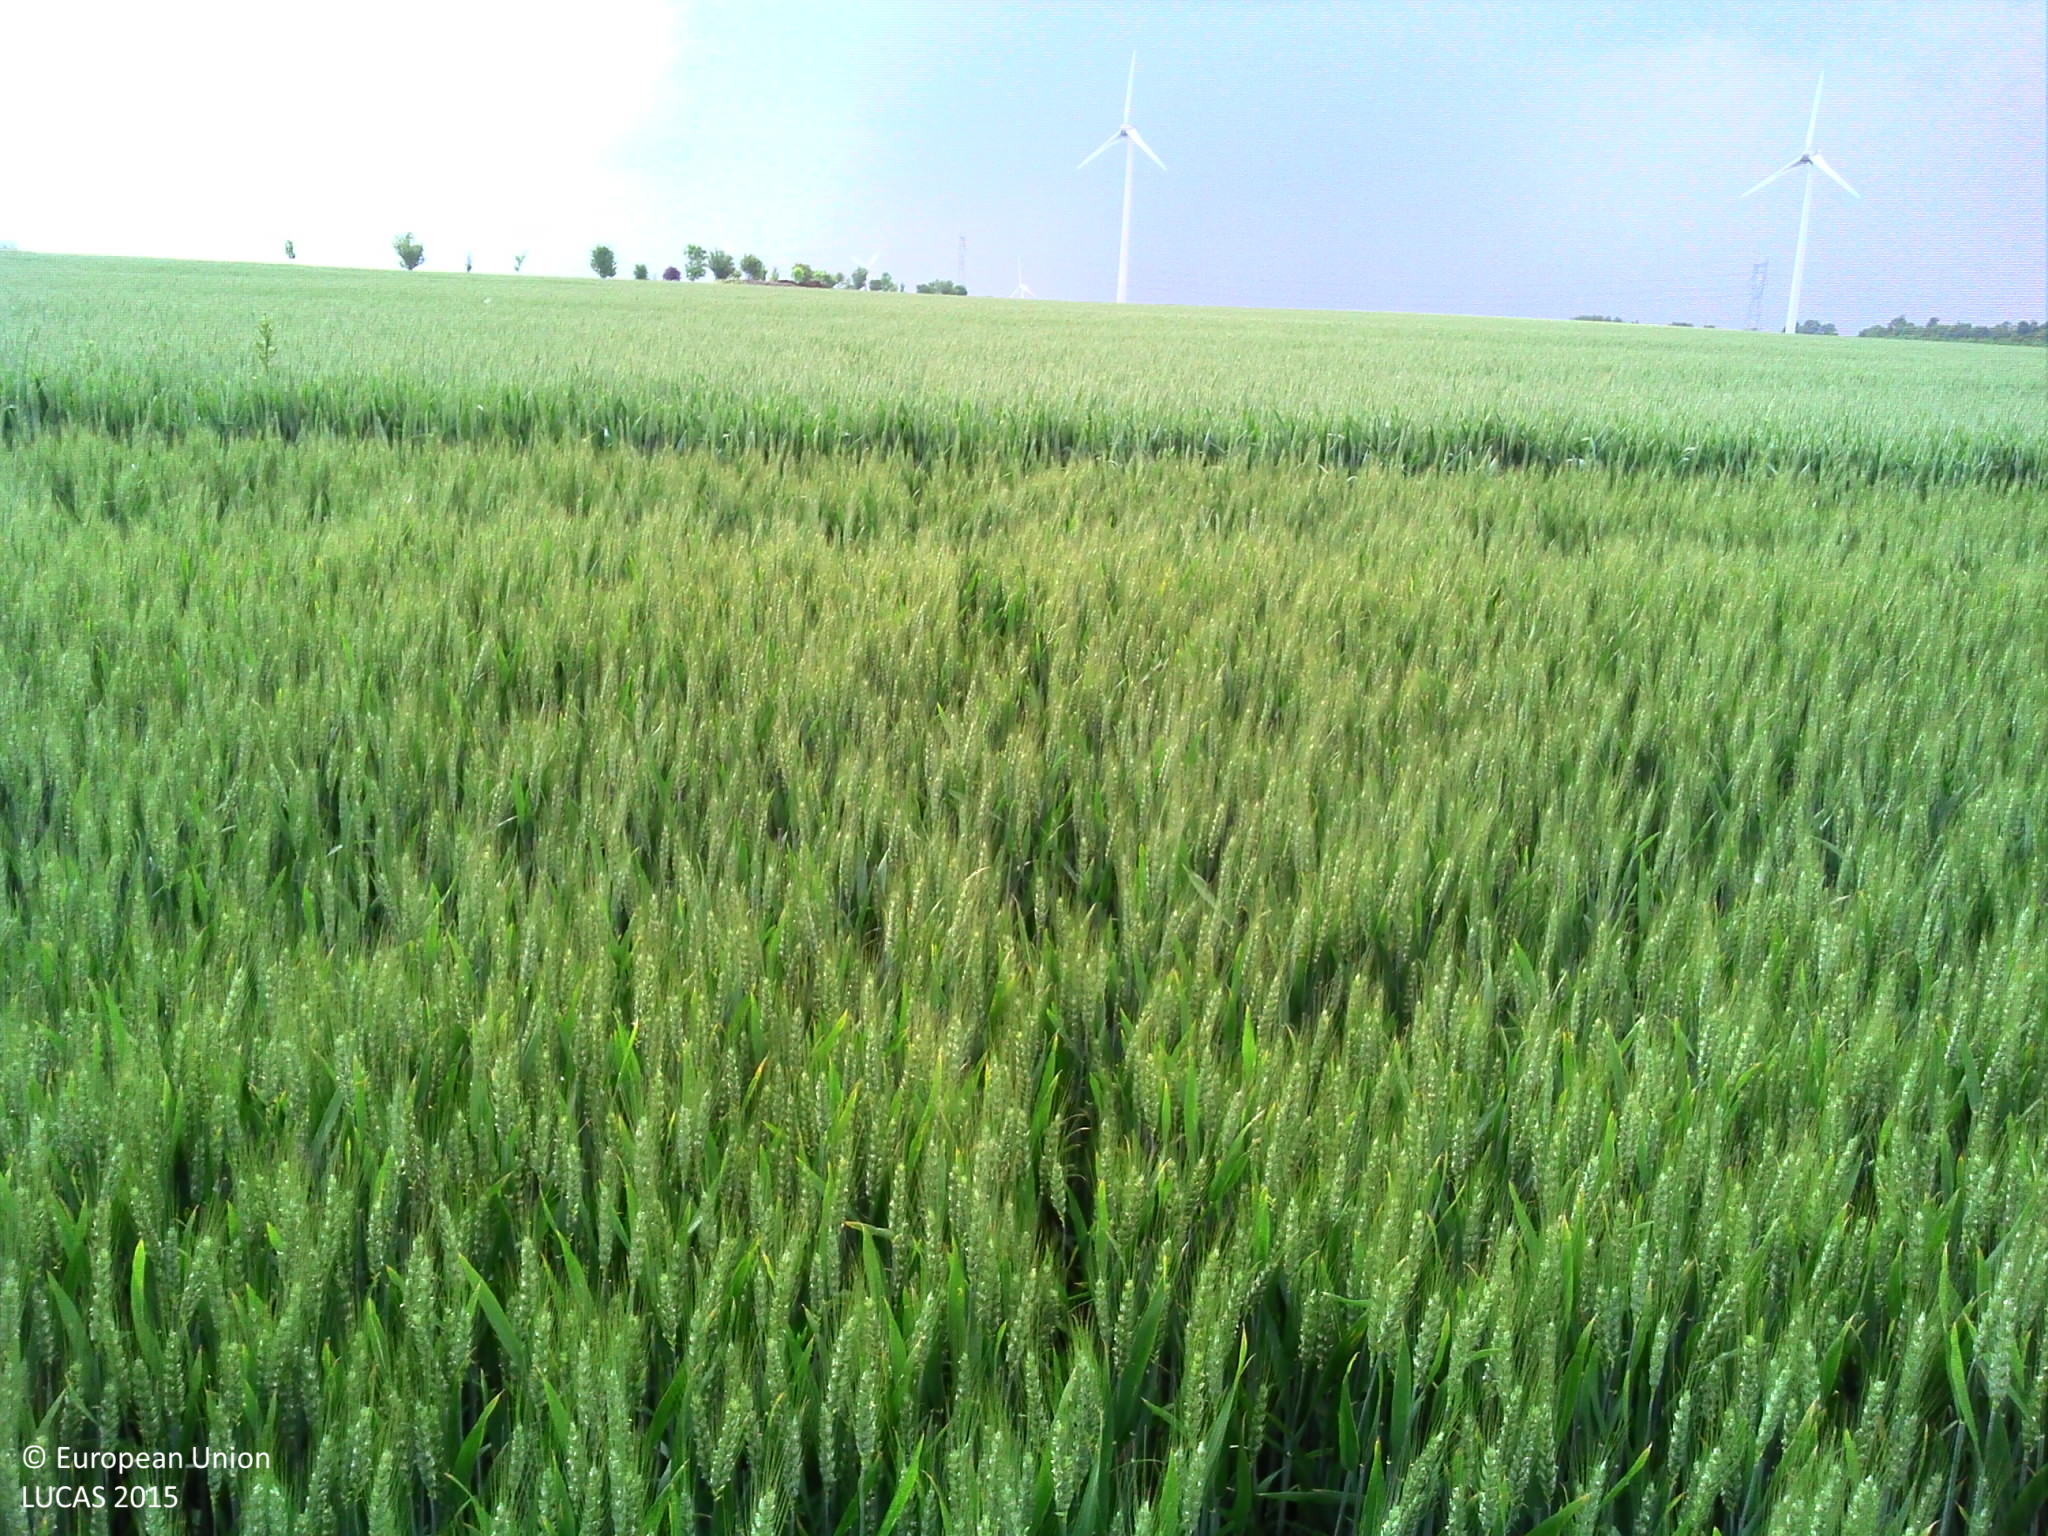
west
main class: Cropland
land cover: Common wheat
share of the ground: > 75 %
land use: Agriculture (excluding fallow land and kitchen gardens)
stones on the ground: 10 - 25 %
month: June
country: FR
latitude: 50.4877
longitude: 2.3613
